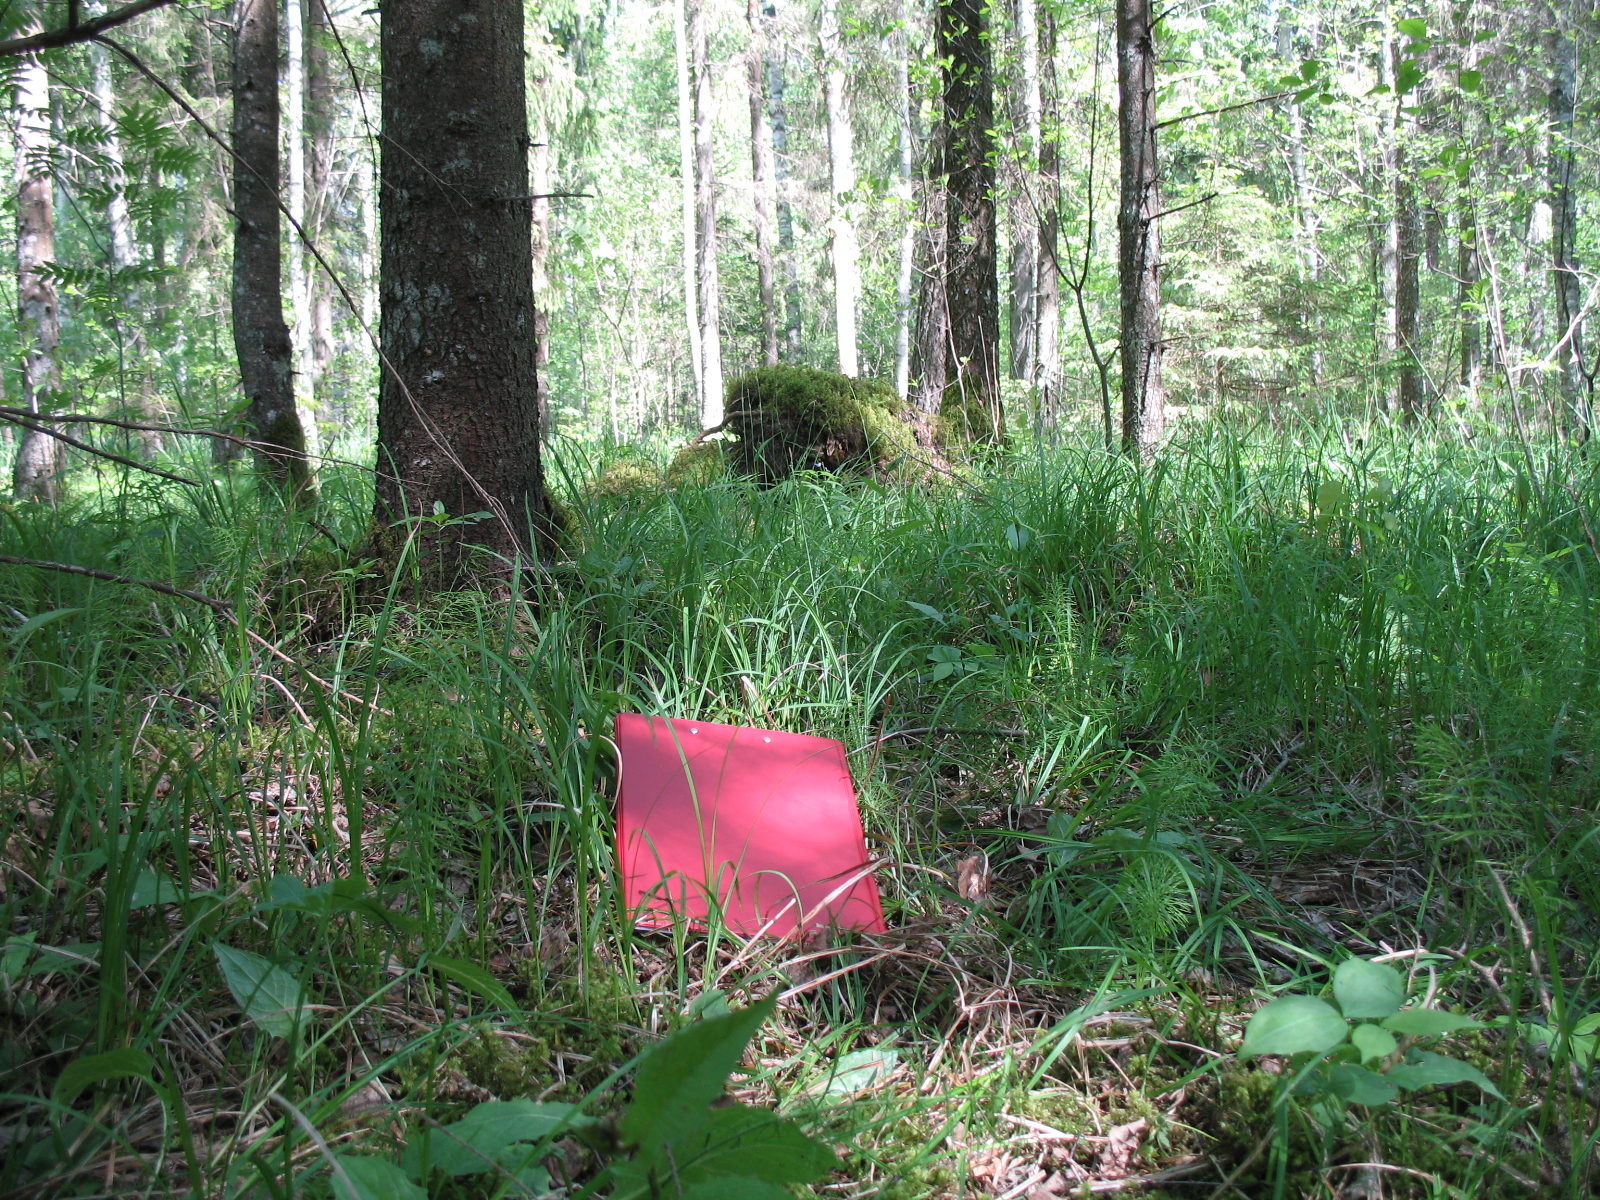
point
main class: Woodland
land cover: Spruce dominated mixed woodland
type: mire and swamp forests
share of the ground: > 75 %
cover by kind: broadleaved forest trees 50 %, coniferous forest trees 45 %, herbaceous plants 5 %
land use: Forestry
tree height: > 5 m
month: May
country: LV
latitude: 56.8541
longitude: 23.5374
